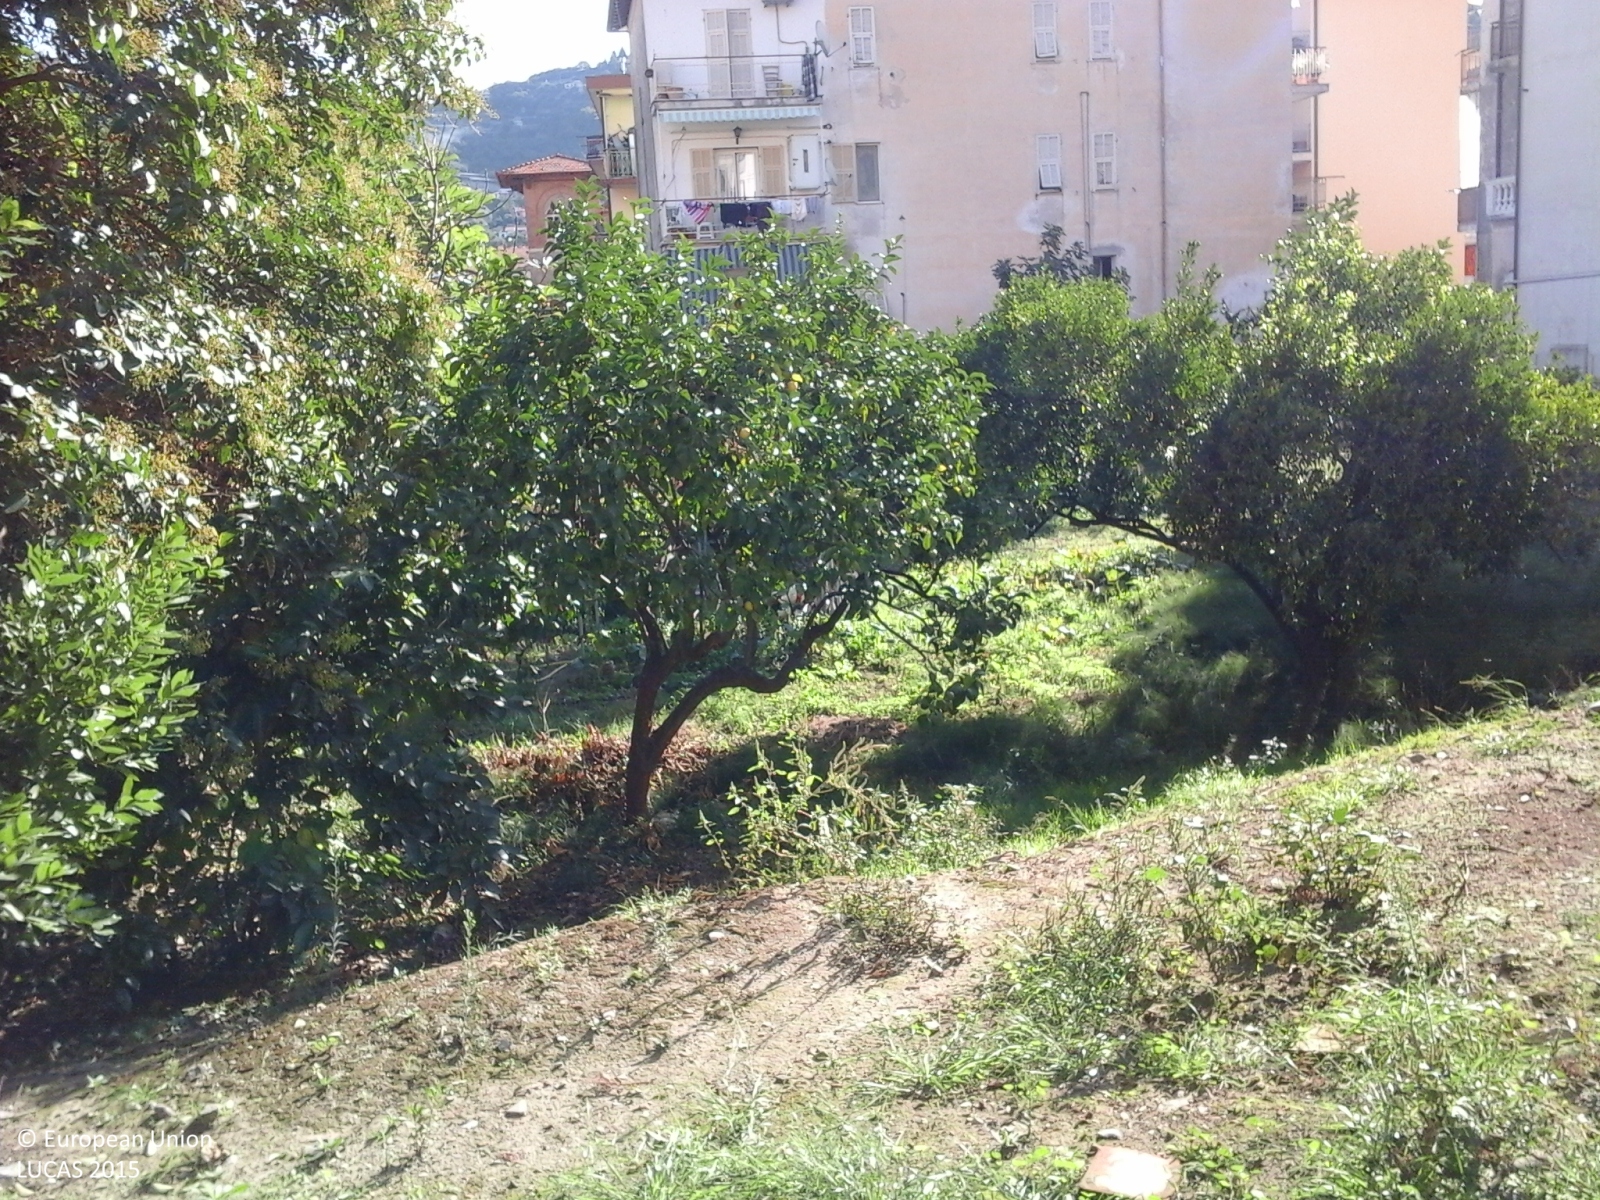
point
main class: Cropland
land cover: Other citrus fruit
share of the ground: 50 - 75 %
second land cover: Grassland without tree/shrub cover
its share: 50 - 75 %
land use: Kitchen garden
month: October
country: IT
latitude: 43.8592
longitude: 7.8529
